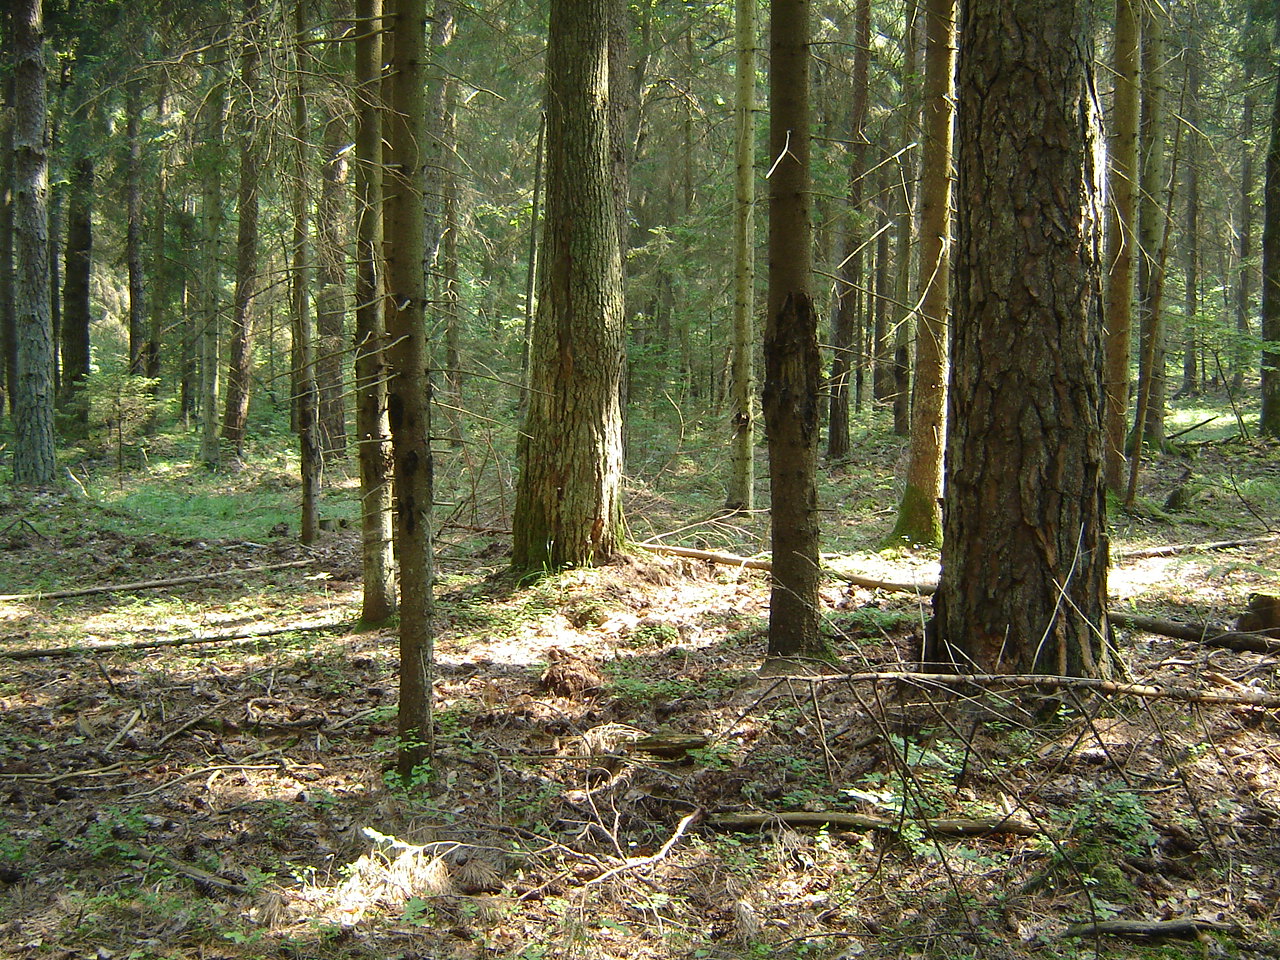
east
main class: Woodland
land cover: Spruce dominated coniferous woodland
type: hemiboreal forest and nemoral coniferous forest and mixed broadleaved-coniferous forest
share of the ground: > 75 %
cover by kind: coniferous forest trees 75 %, broadleaved forest trees 10 %, lichens and mosses 10 %, herbaceous plants 5 %
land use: Forestry
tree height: > 5 m
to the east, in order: Spruce dominated coniferous woodland; Pine dominated mixed woodland
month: August
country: LT
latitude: 54.8951
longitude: 25.0045
